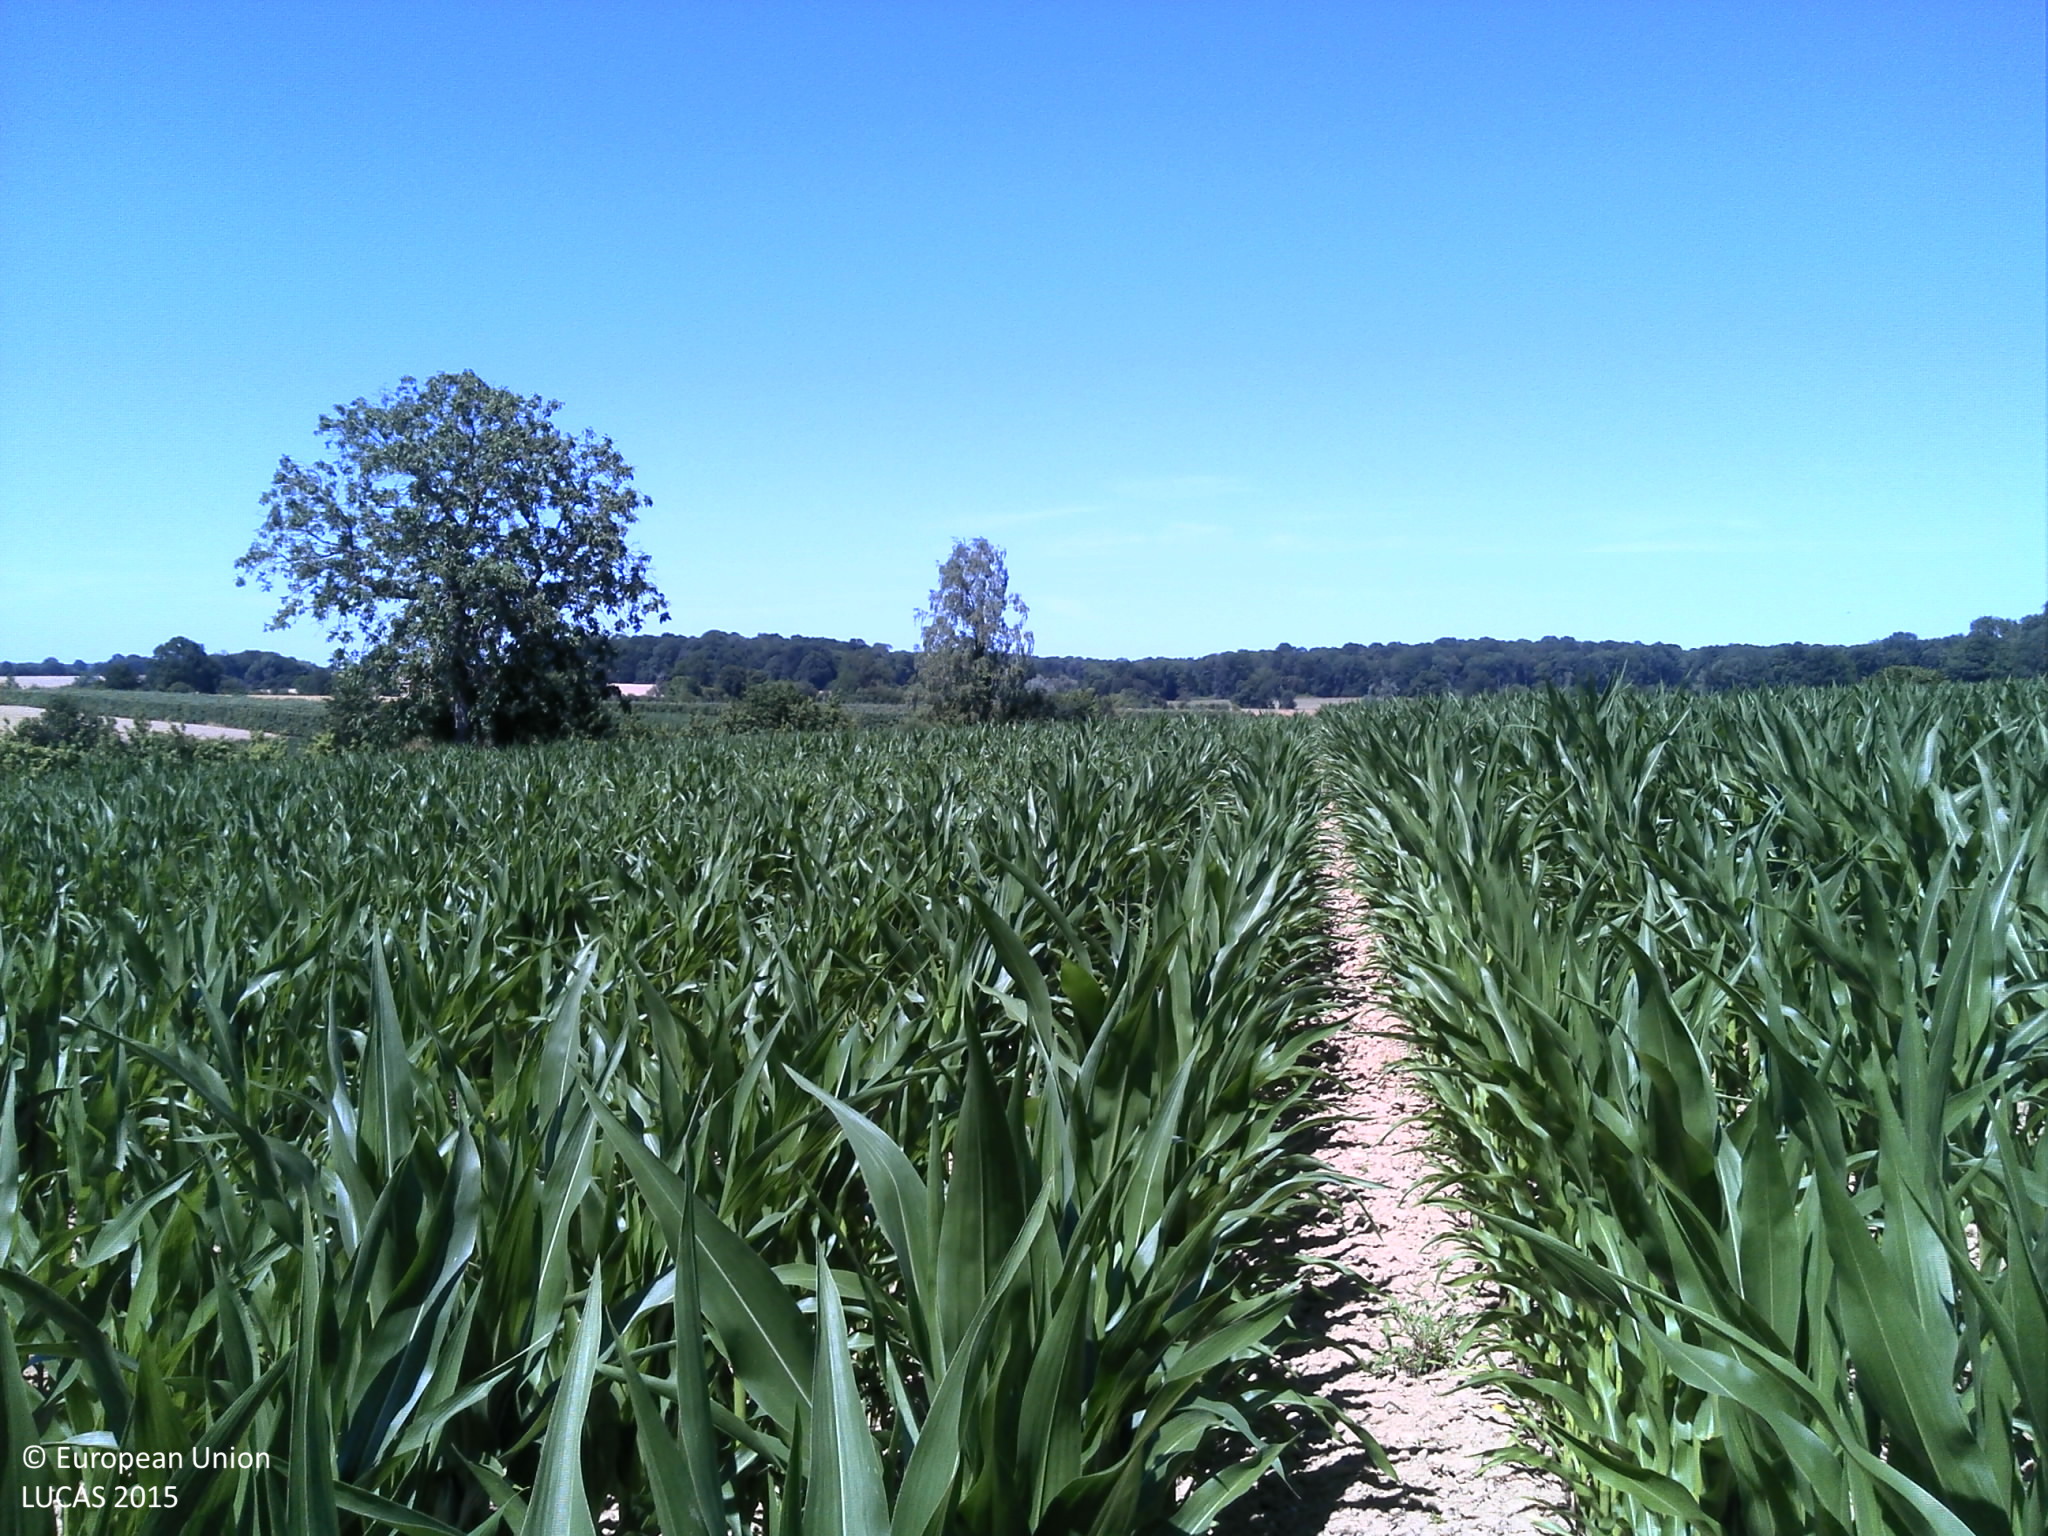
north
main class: Cropland
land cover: Maize
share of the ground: > 75 %
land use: Agriculture (excluding fallow land and kitchen gardens)
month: July
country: FR
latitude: 49.5180
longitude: 4.6510
